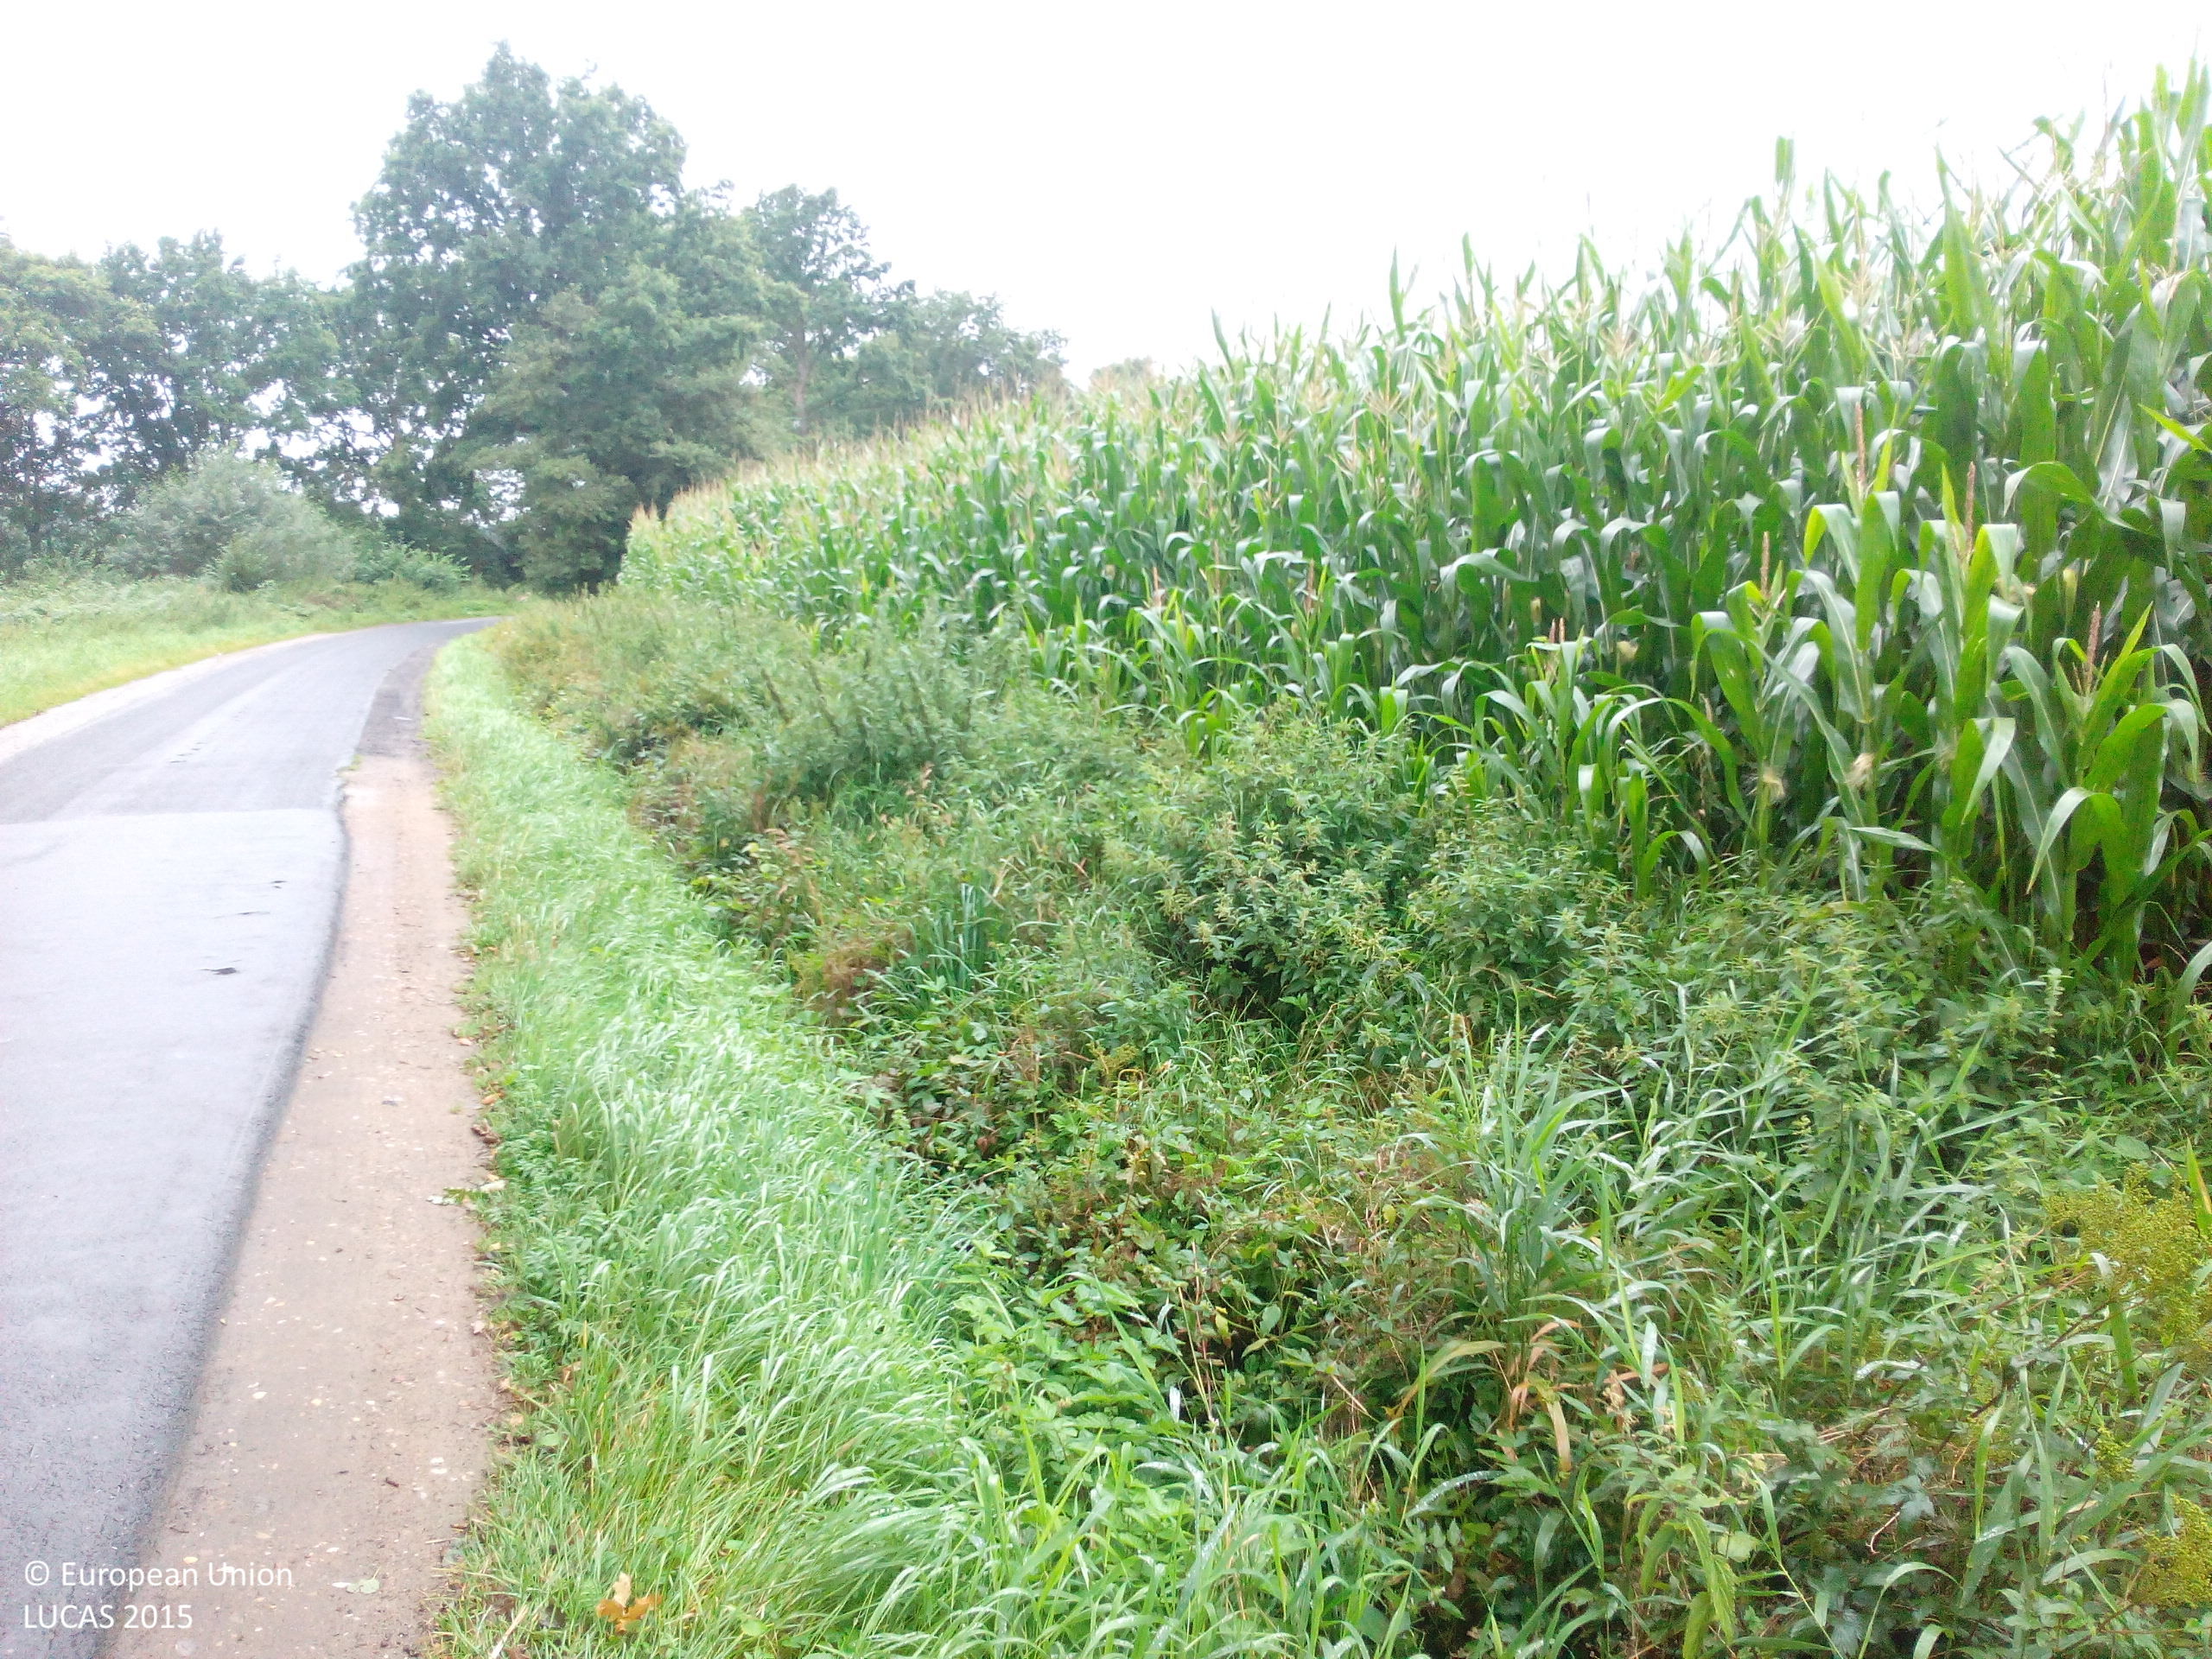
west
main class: Cropland
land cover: Maize
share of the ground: > 75 %
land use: Agriculture (excluding fallow land and kitchen gardens)
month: August
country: DE
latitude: 53.7613
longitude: 9.8939
